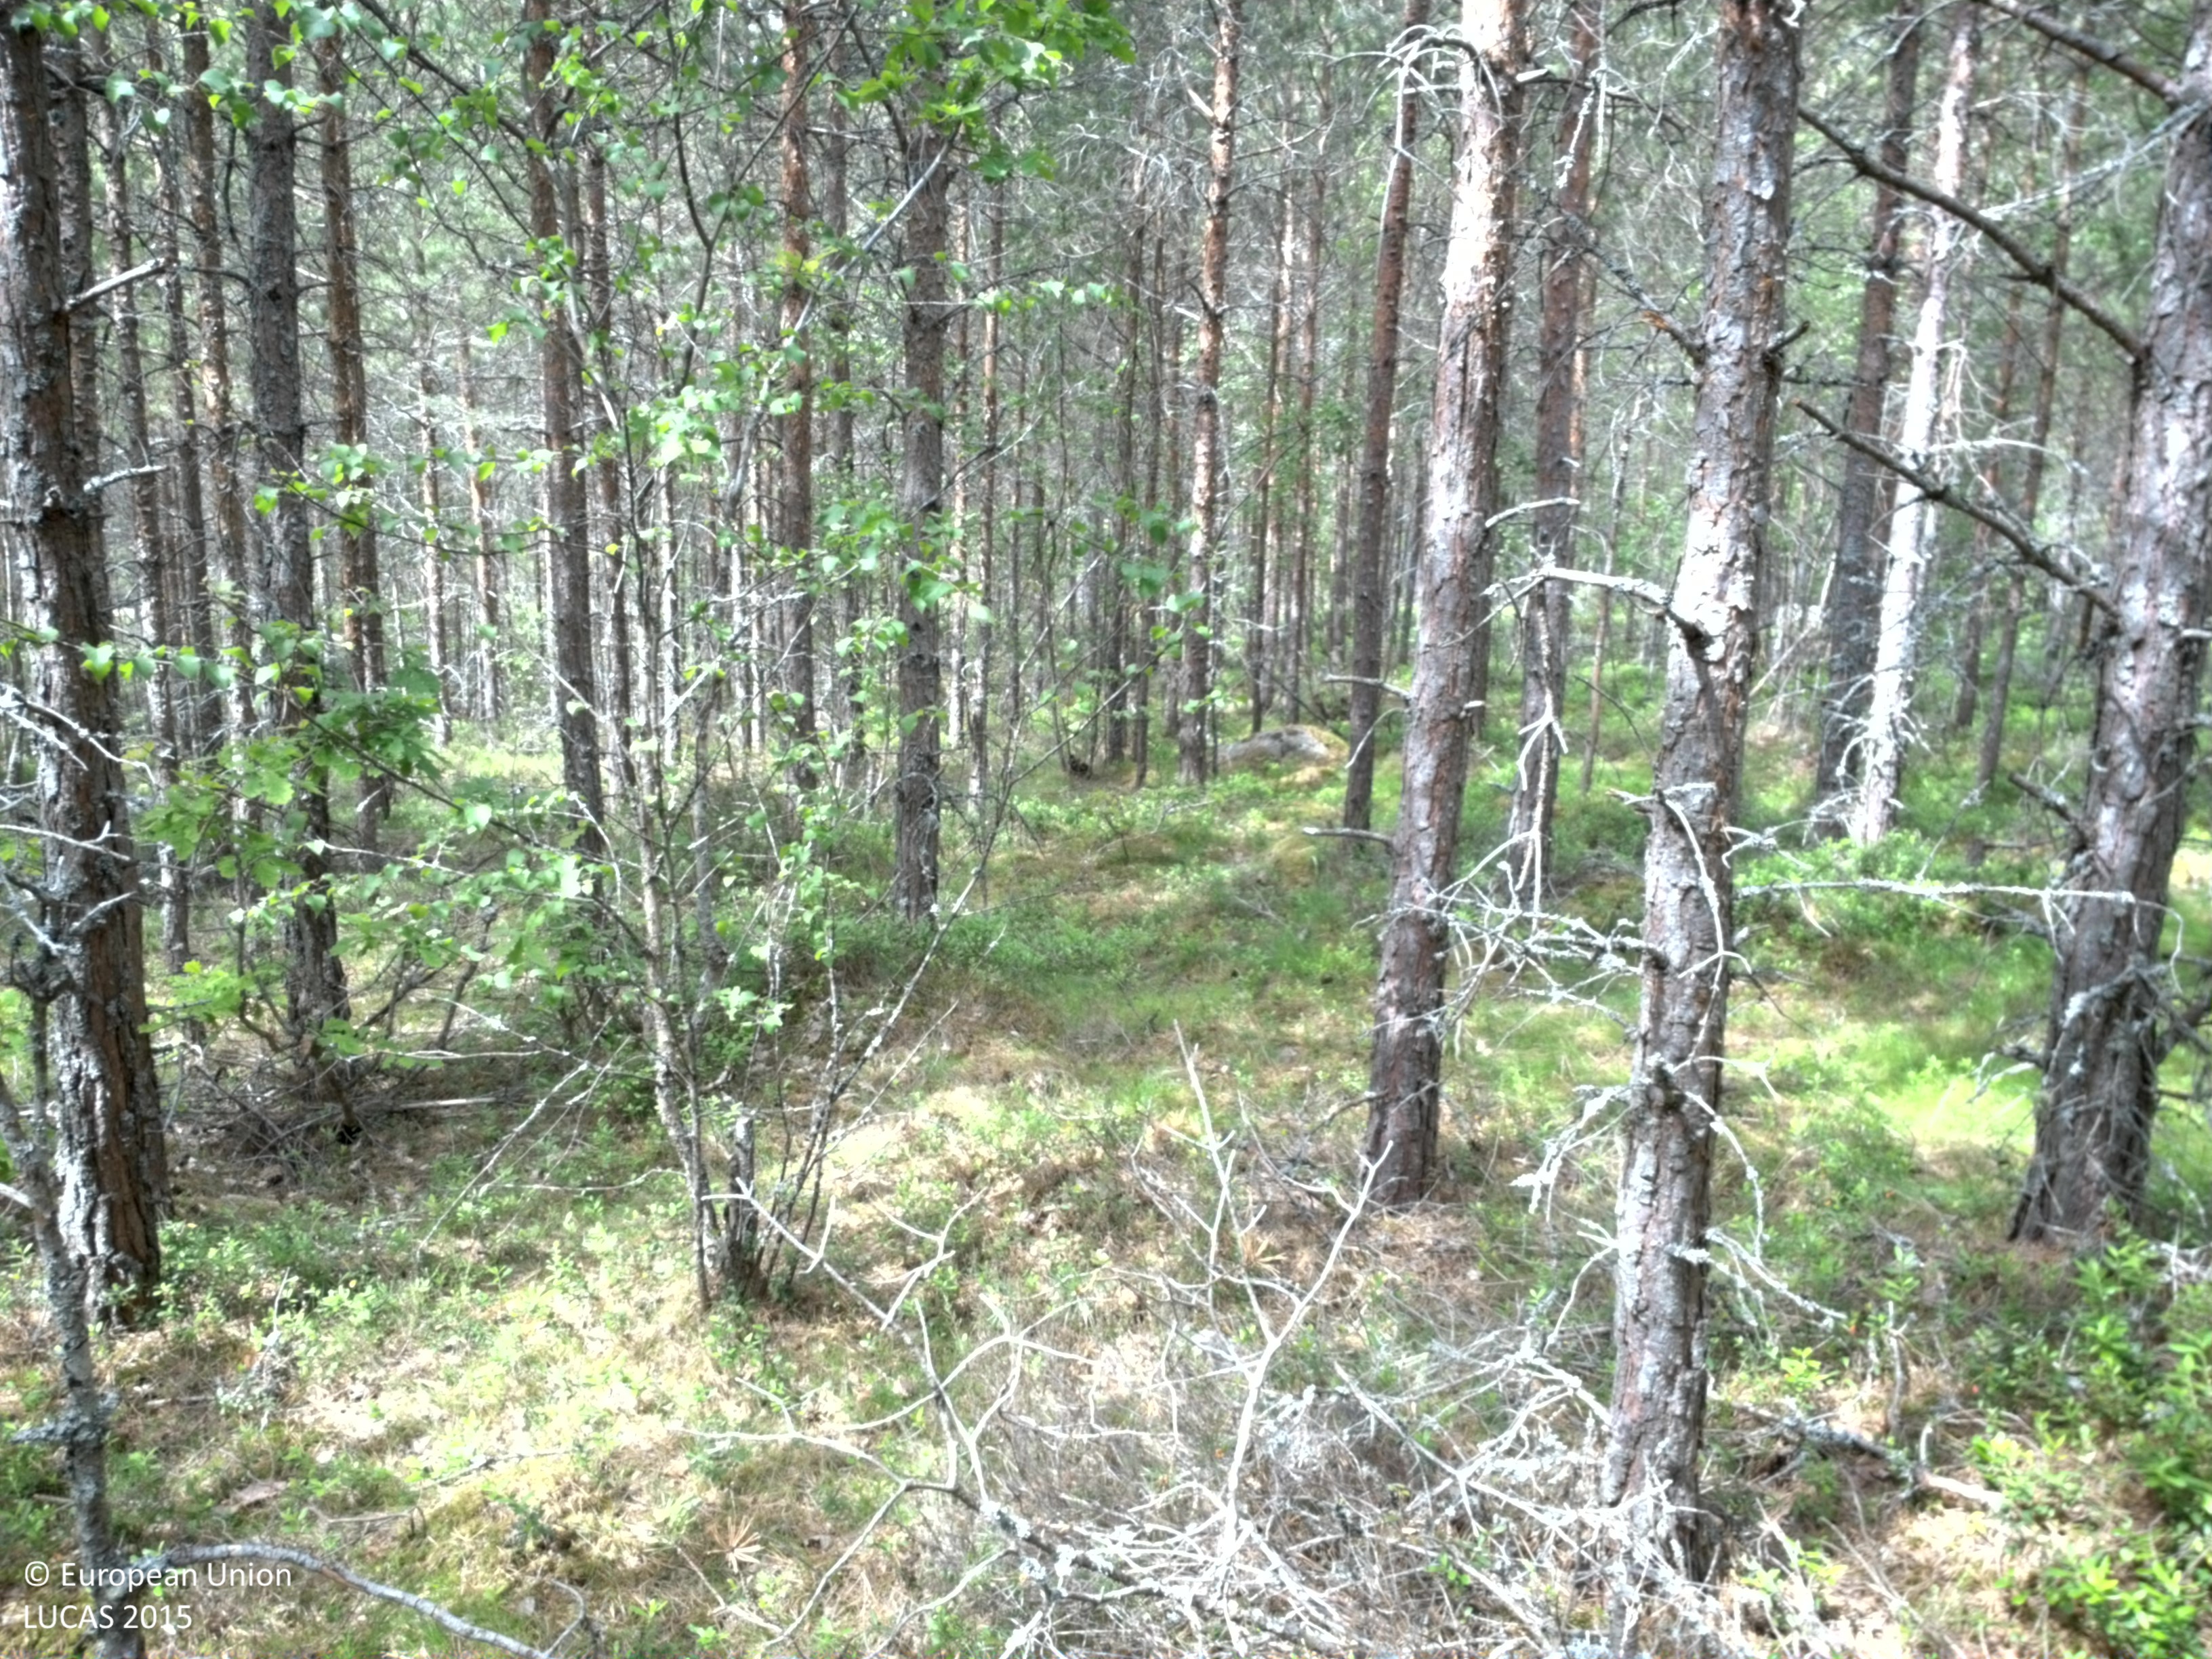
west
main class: Woodland
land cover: Pine dominated coniferous woodland
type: boreal forest
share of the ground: 25 - 50 %
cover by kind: coniferous forest trees 40 %, herbaceous plants 40 %, lichens and mosses 15 %, broadleaved forest trees 5 %
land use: Forestry
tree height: < 5 m
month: June
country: SE
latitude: 58.5295
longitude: 16.1605
